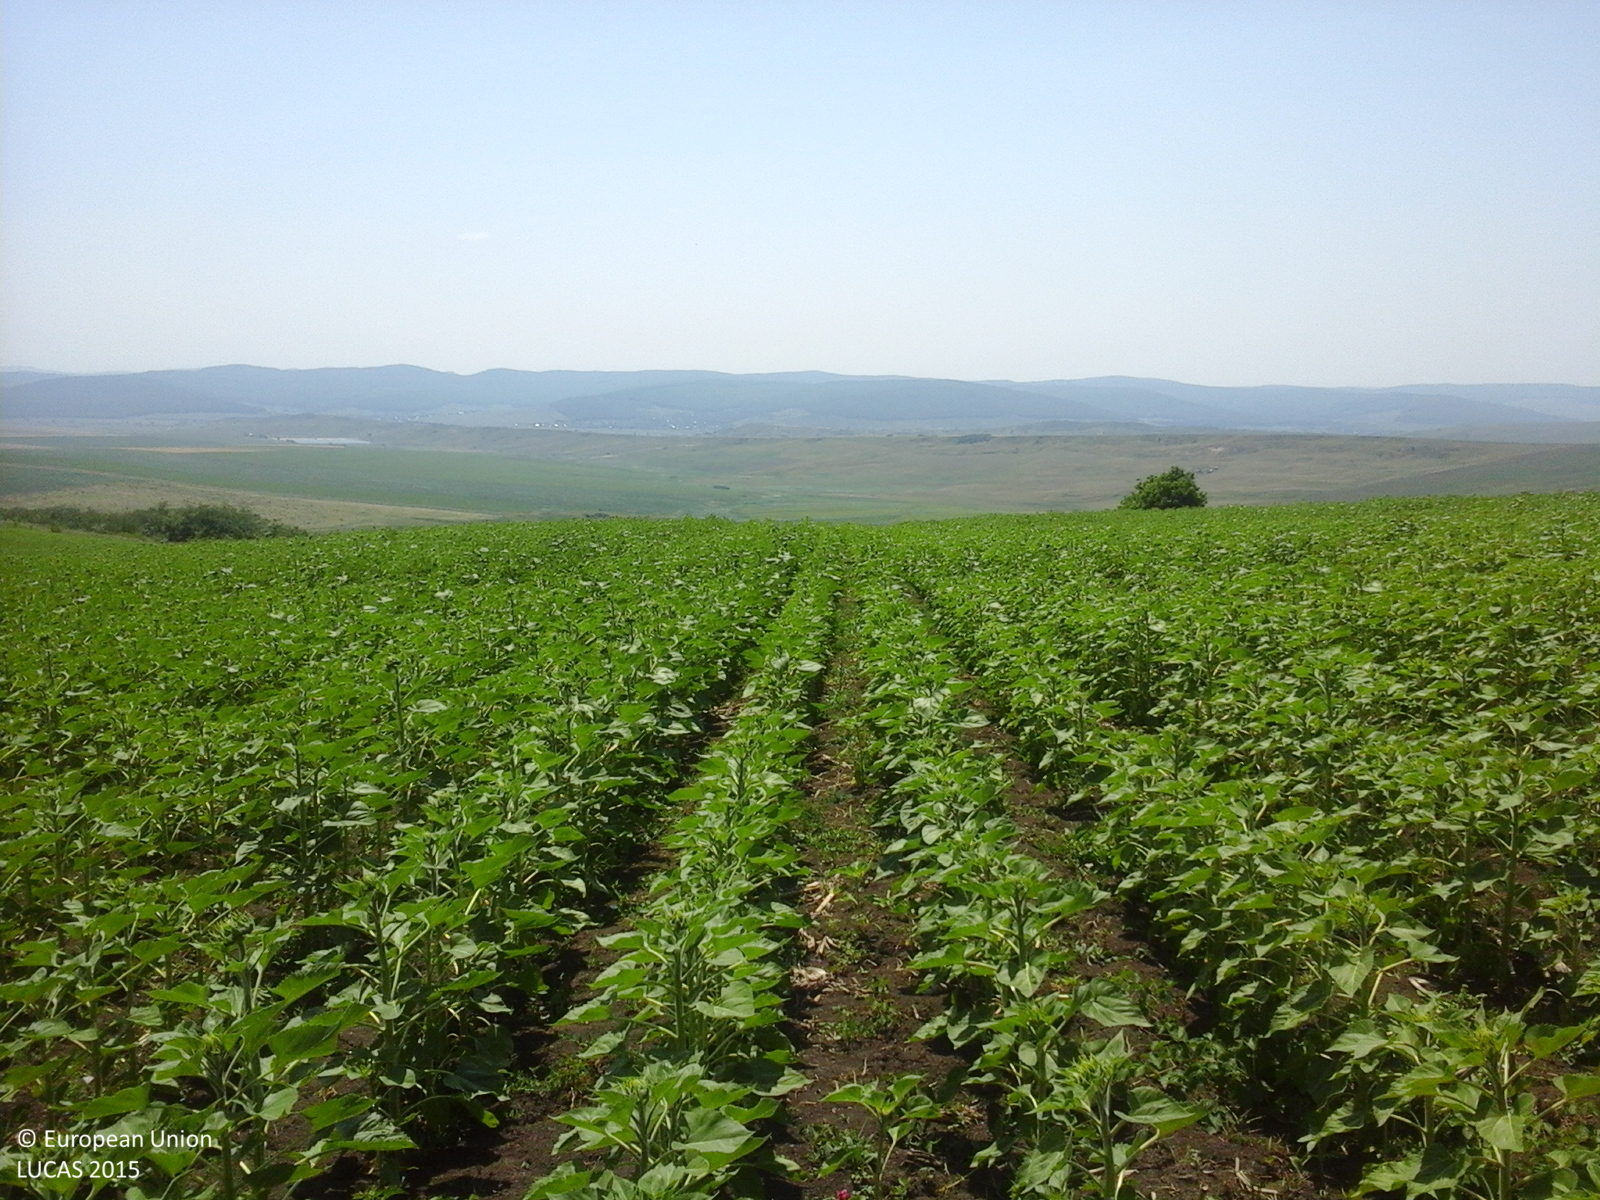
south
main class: Cropland
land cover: Sunflower
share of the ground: > 75 %
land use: Agriculture (excluding fallow land and kitchen gardens)
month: June
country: RO
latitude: 46.8985
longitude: 27.2898
